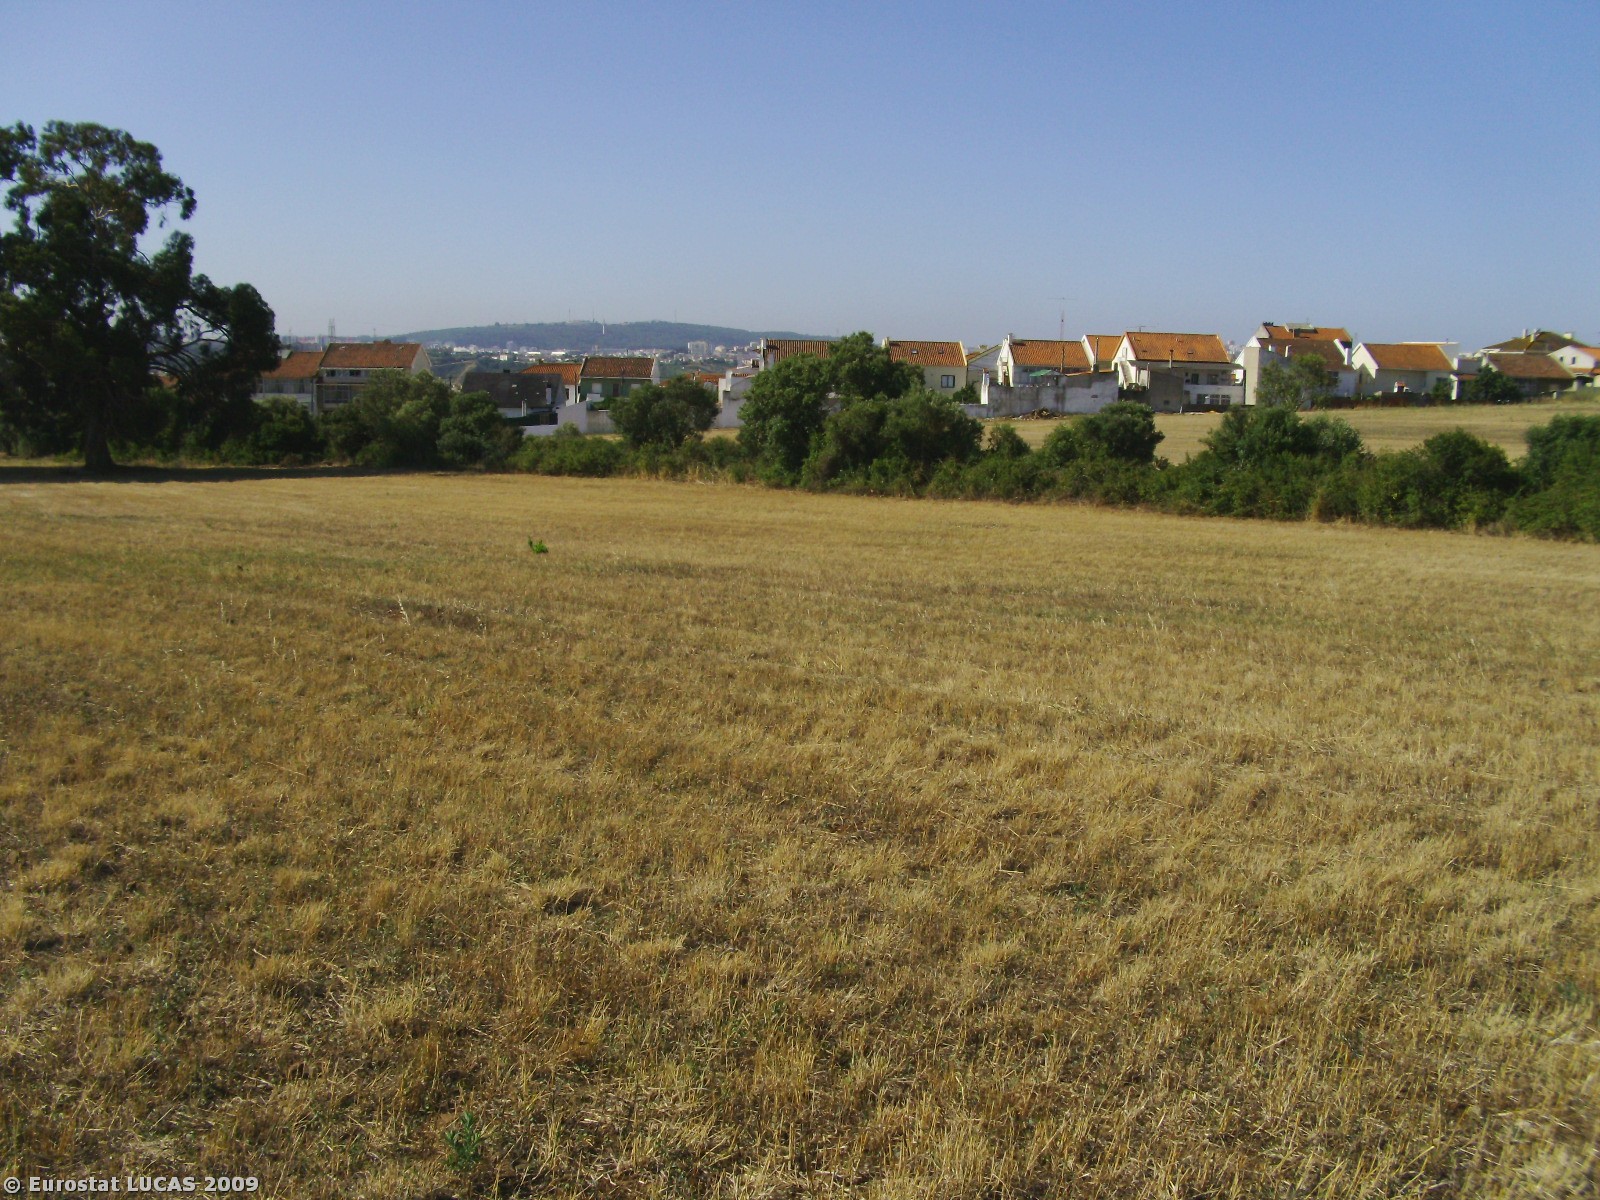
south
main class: Cropland
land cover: Temporary grasslands
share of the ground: > 75 %
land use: Agriculture (excluding fallow land and kitchen gardens)
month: July
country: PT
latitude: 38.7951
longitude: -9.2025
